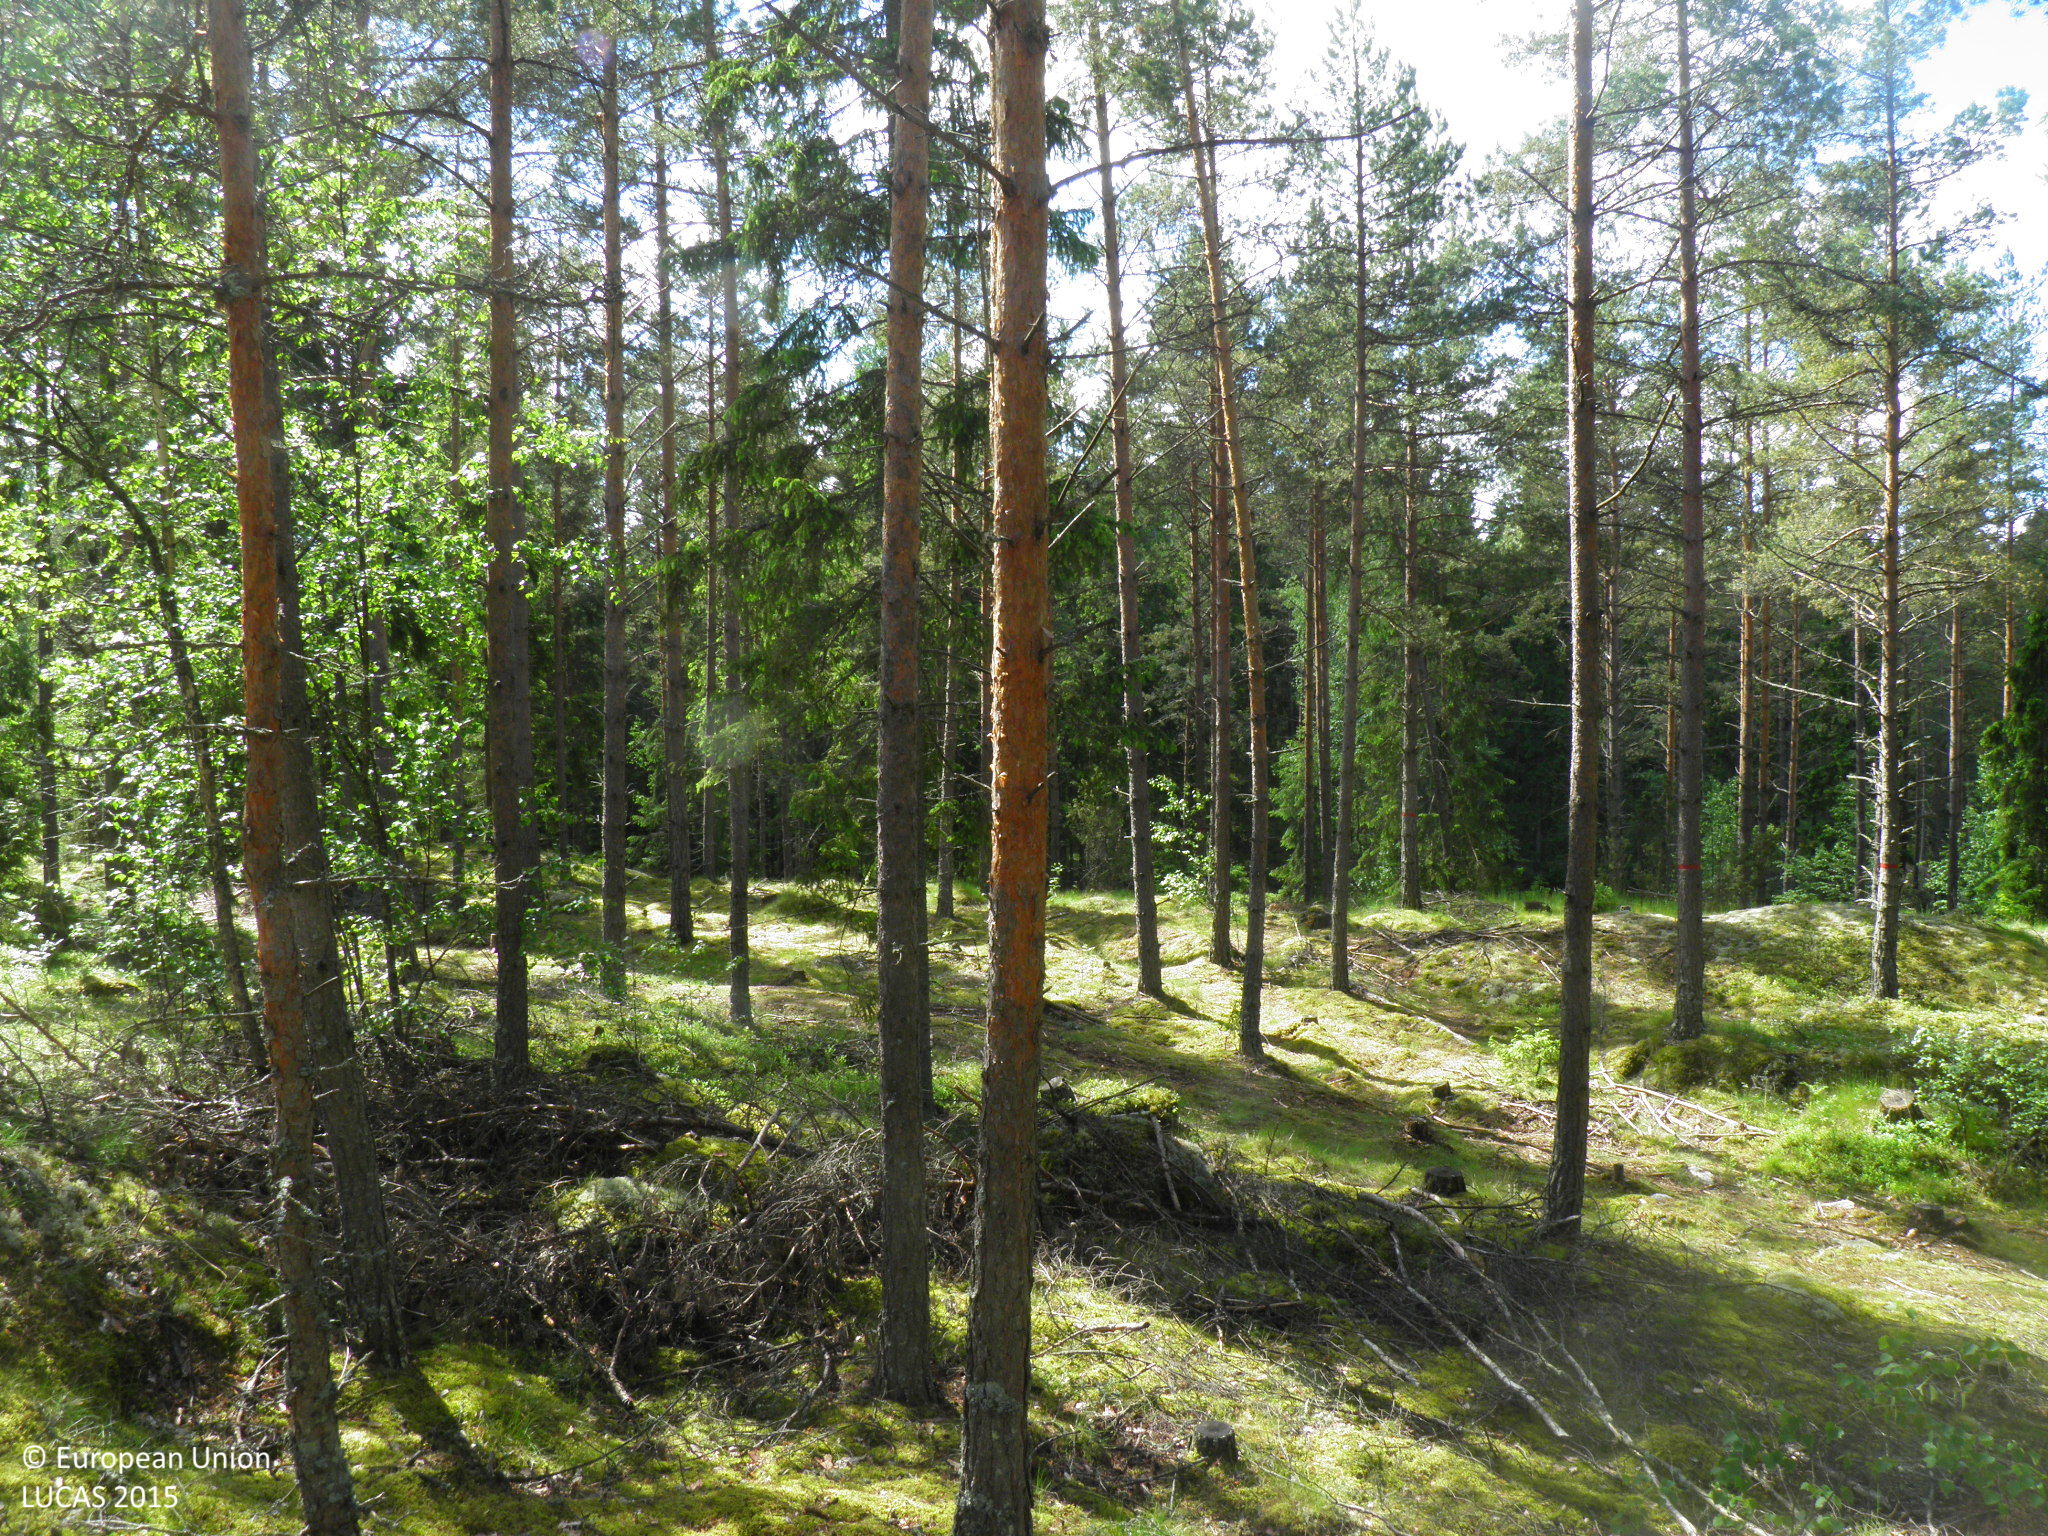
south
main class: Woodland
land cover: Pine dominated coniferous woodland
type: boreal forest
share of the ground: > 75 %
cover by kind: coniferous forest trees 80 %, lichens and mosses 10 %, shrubs 5 %, consolidated bare surface 5 %
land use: Forestry
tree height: > 5 m
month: June
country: FI
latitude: 60.5977
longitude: 21.9864
